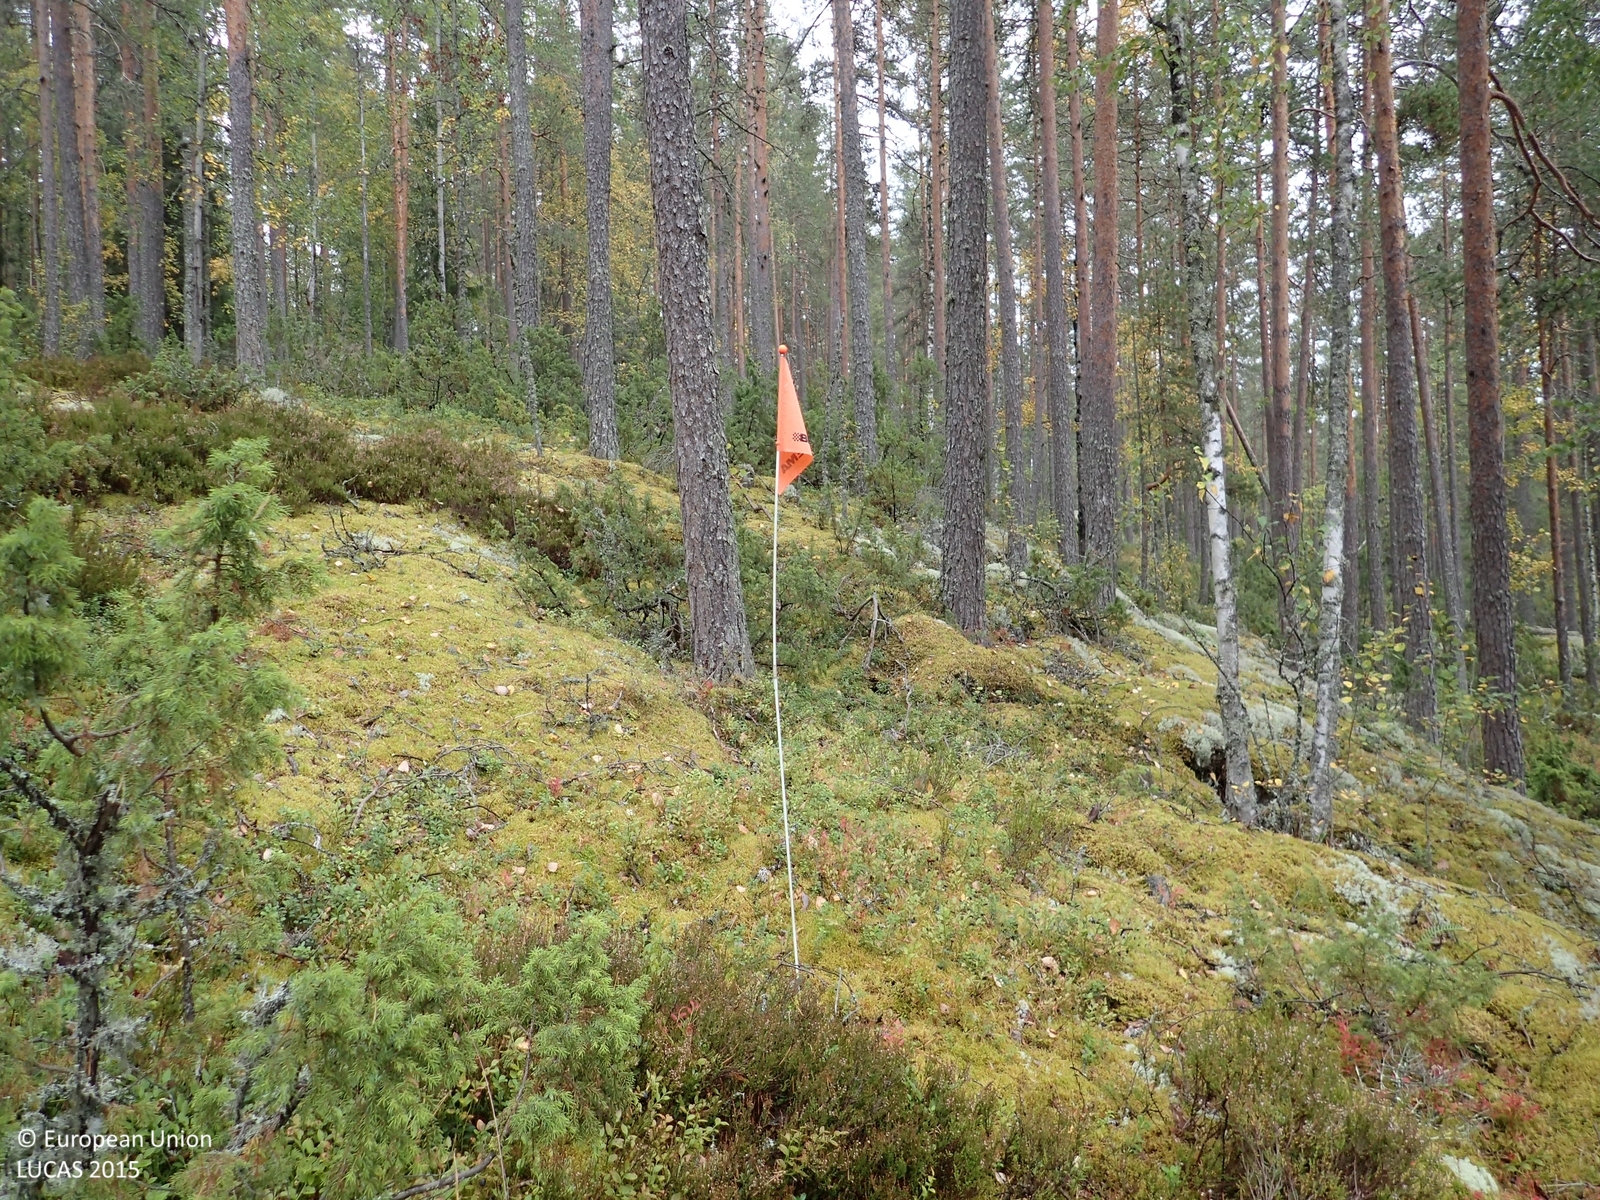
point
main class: Woodland
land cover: Pine dominated mixed woodland
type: boreal forest
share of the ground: > 75 %
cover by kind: coniferous forest trees 55 %, broadleaved forest trees 20 %, lichens and mosses 15 %, shrubs 10 %
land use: Forestry
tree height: > 5 m
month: September
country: FI
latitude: 63.0650
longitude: 25.6022
